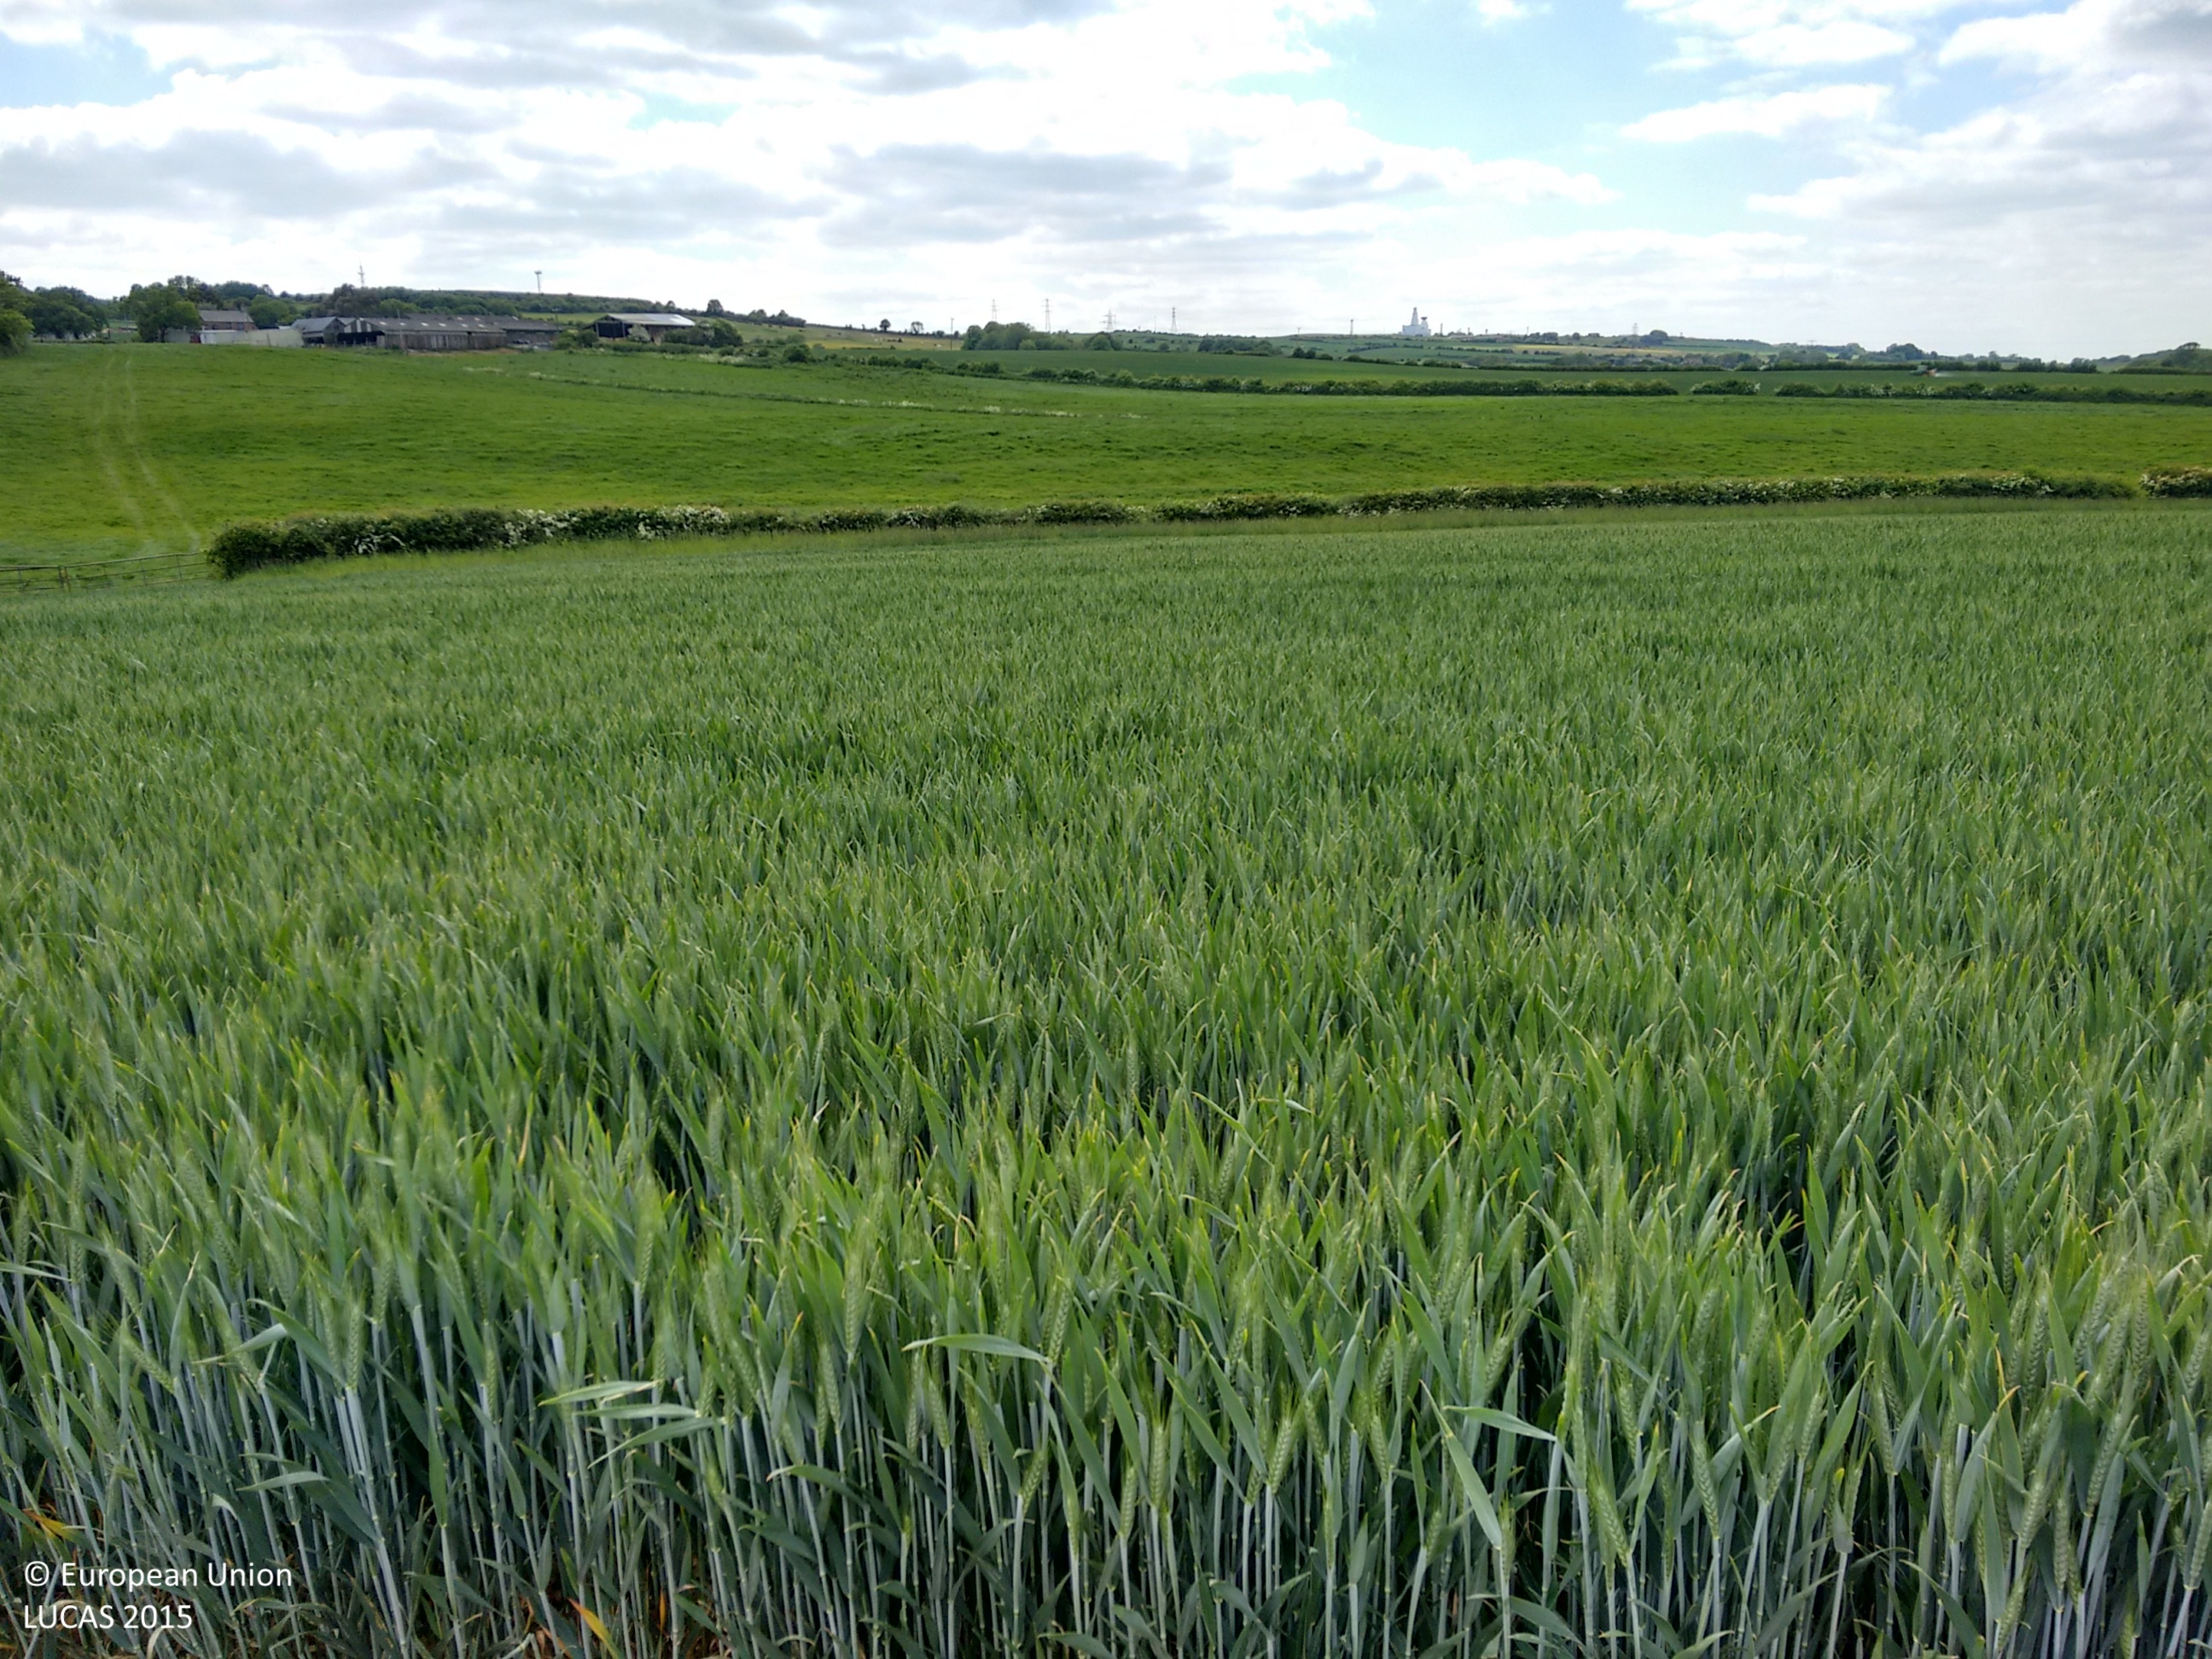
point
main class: Cropland
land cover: Common wheat
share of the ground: > 75 %
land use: Agriculture (excluding fallow land and kitchen gardens)
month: May
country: GB
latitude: 50.8610
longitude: -1.0556
